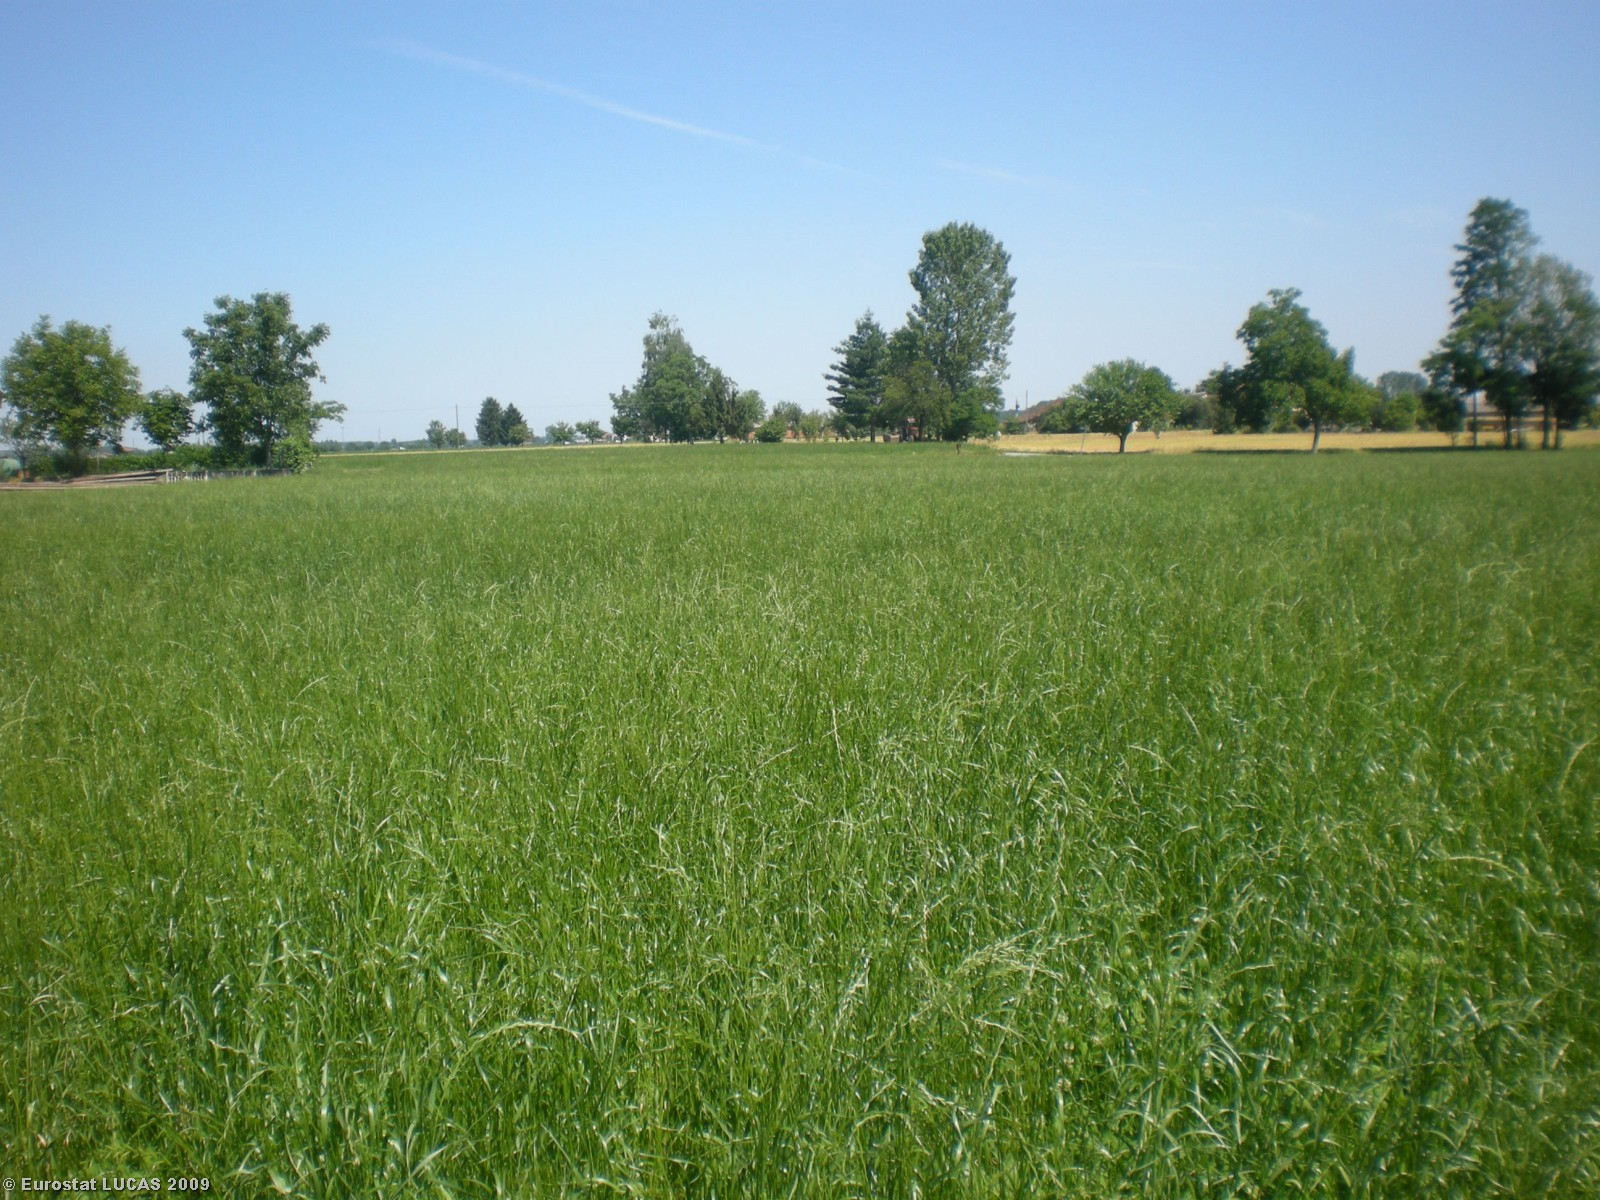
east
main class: Cropland
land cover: Temporary grasslands
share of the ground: > 75 %
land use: Agriculture (excluding fallow land and kitchen gardens)
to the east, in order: Temporary grasslands; Ditches and canals; Temporary grasslands; Paved roads, cycling and walking lanes; Clovers; Grass margins; Paved roads, cycling and walking lanes; Grass margins; Temporary grasslands; Common wheat
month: June
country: IT
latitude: 44.7508
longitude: 7.3902
